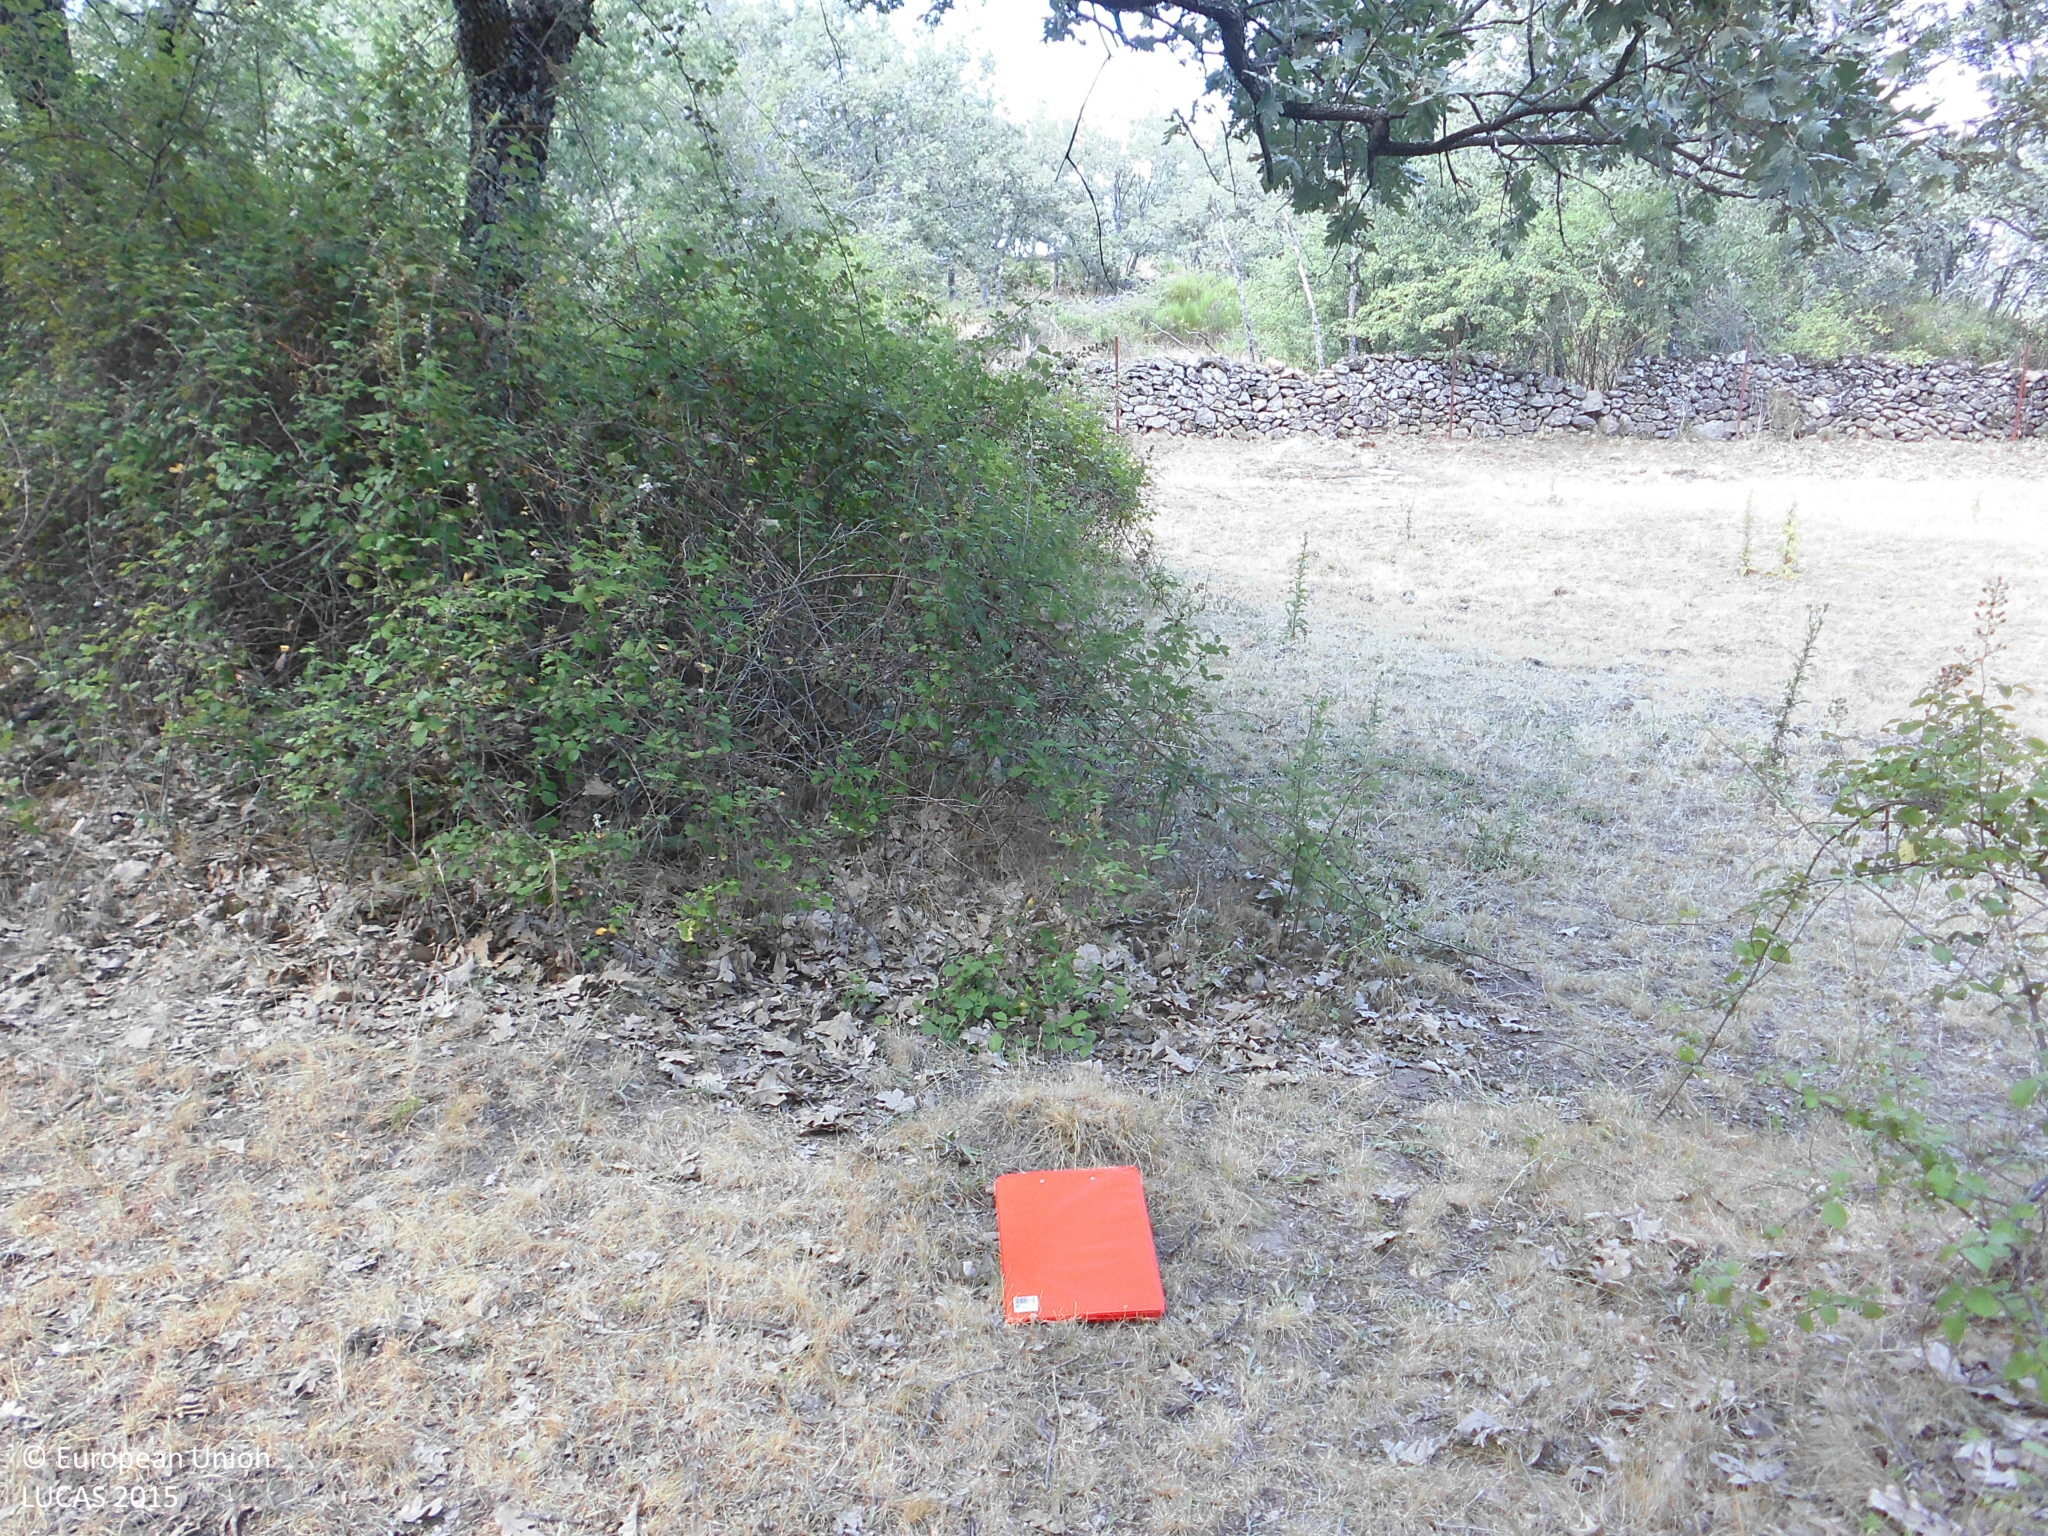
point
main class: Woodland
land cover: Broadleaved woodland
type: thermophilous deciduous forest
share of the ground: > 75 %
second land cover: Grassland without tree/shrub cover
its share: > 75 %
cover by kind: broadleaved forest trees 80 %, herbaceous plants 20 %
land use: Forestry
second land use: Agriculture (excluding fallow land and kitchen gardens)
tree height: > 5 m
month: June
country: ES
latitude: 40.0386
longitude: -5.9493
